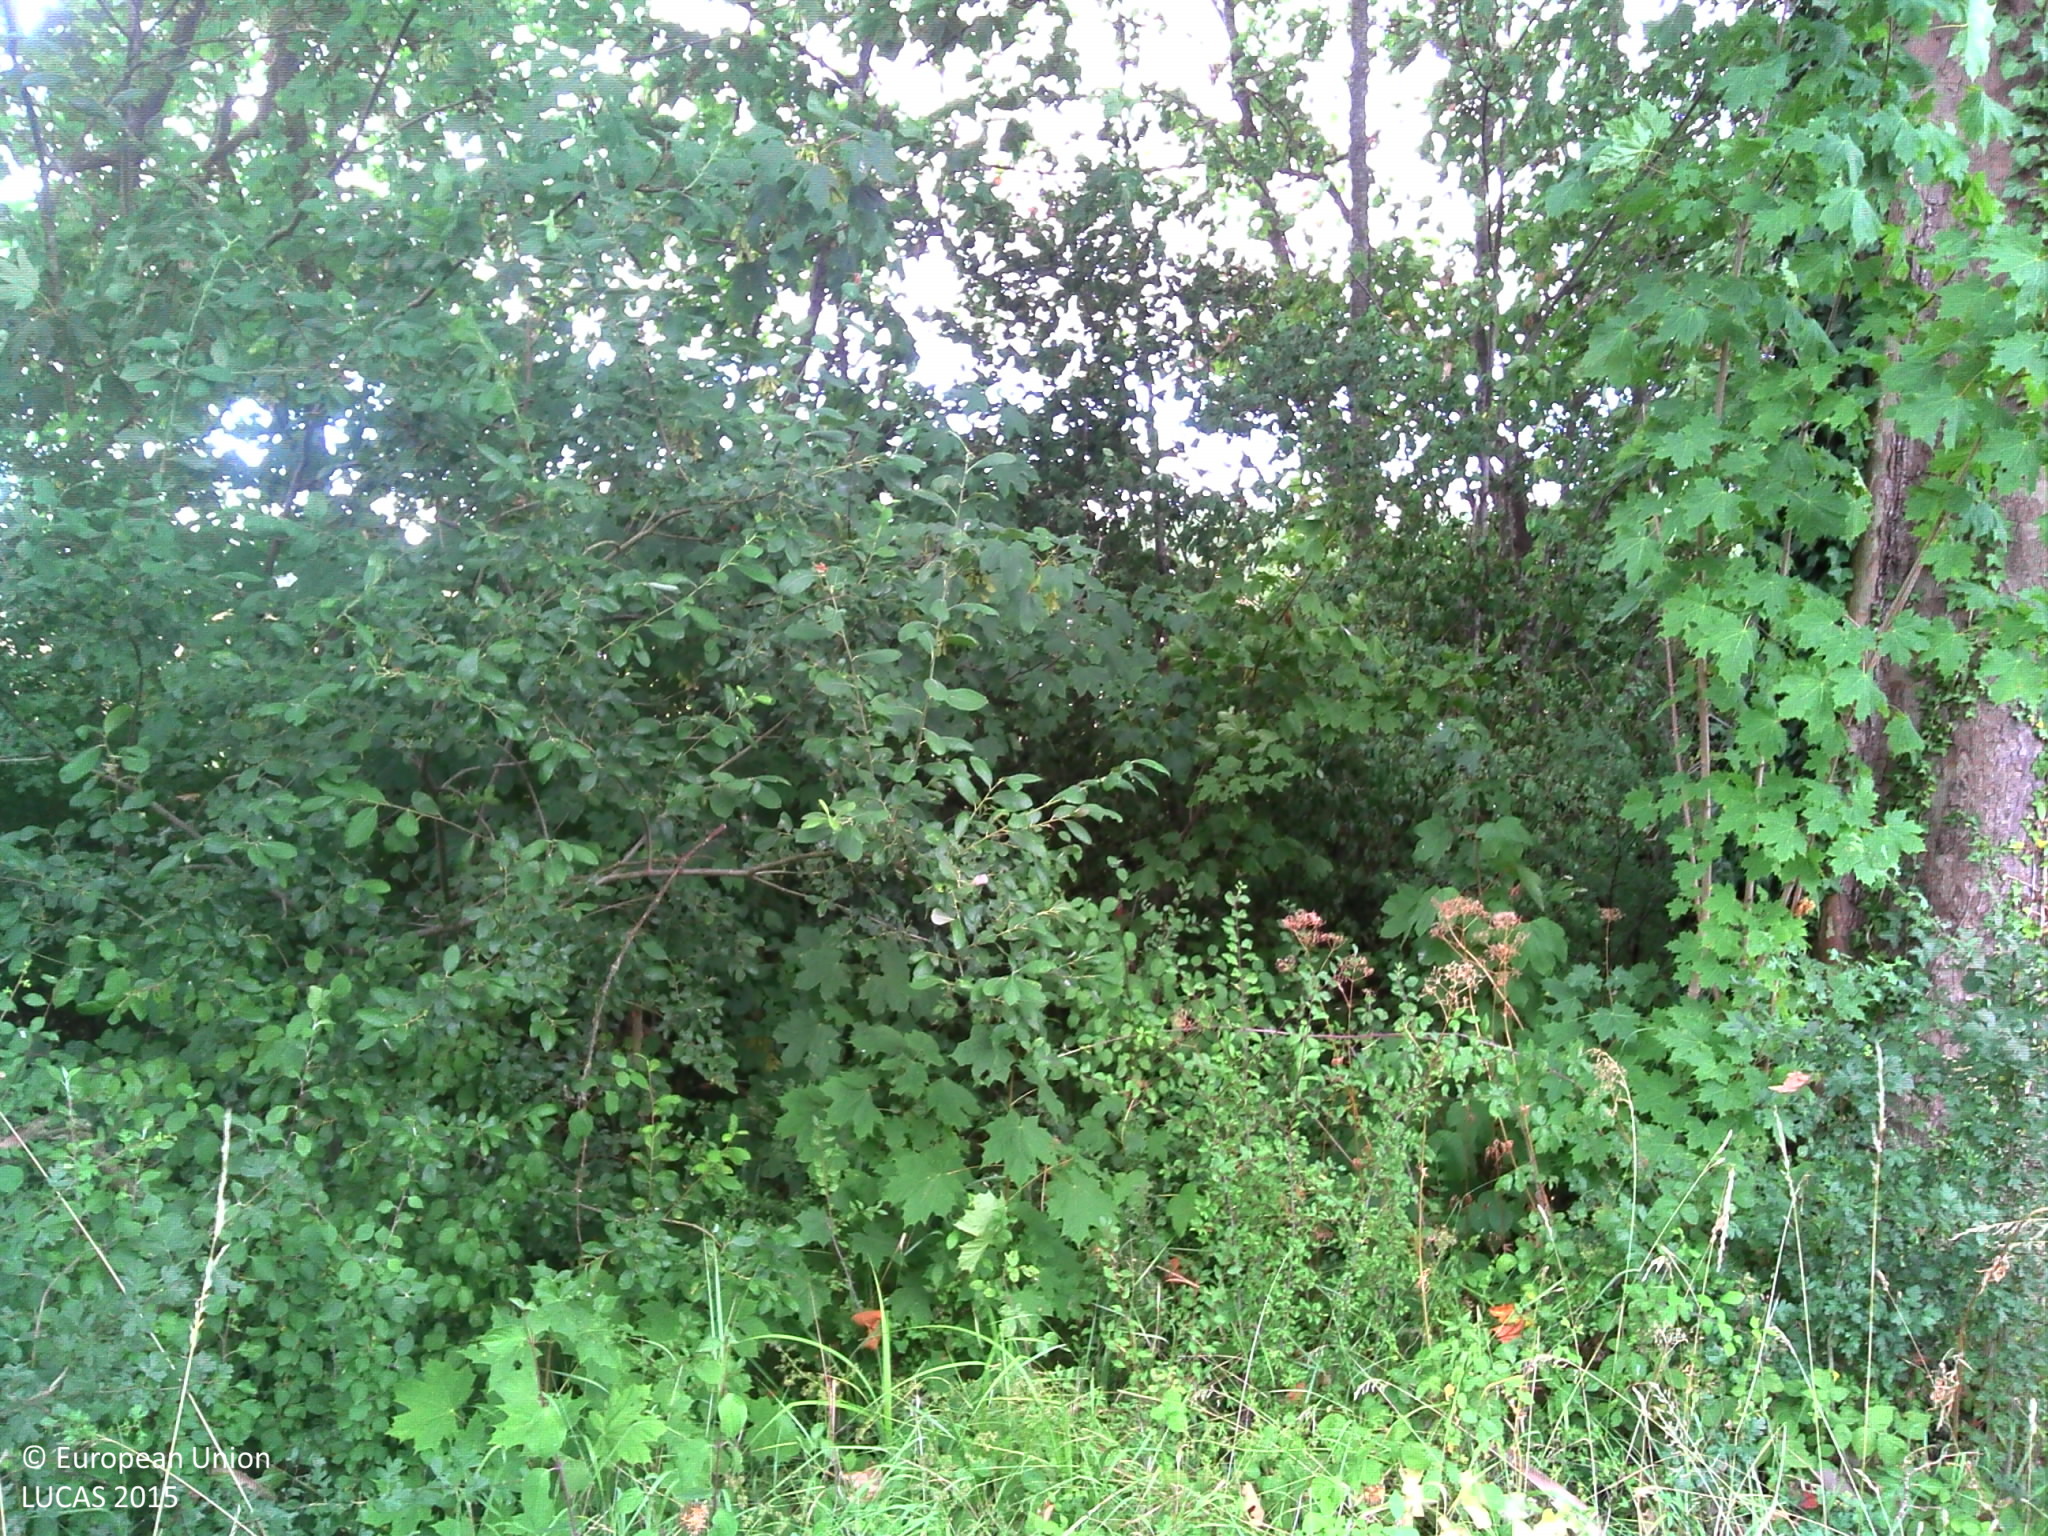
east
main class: Grassland
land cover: Grassland without tree/shrub cover
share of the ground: > 75 %
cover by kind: herbaceous plants 100 %
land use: Agriculture (excluding fallow land and kitchen gardens)
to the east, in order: Grassland without tree/shrub cover
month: July
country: FR
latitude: 46.9644
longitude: 3.1755
